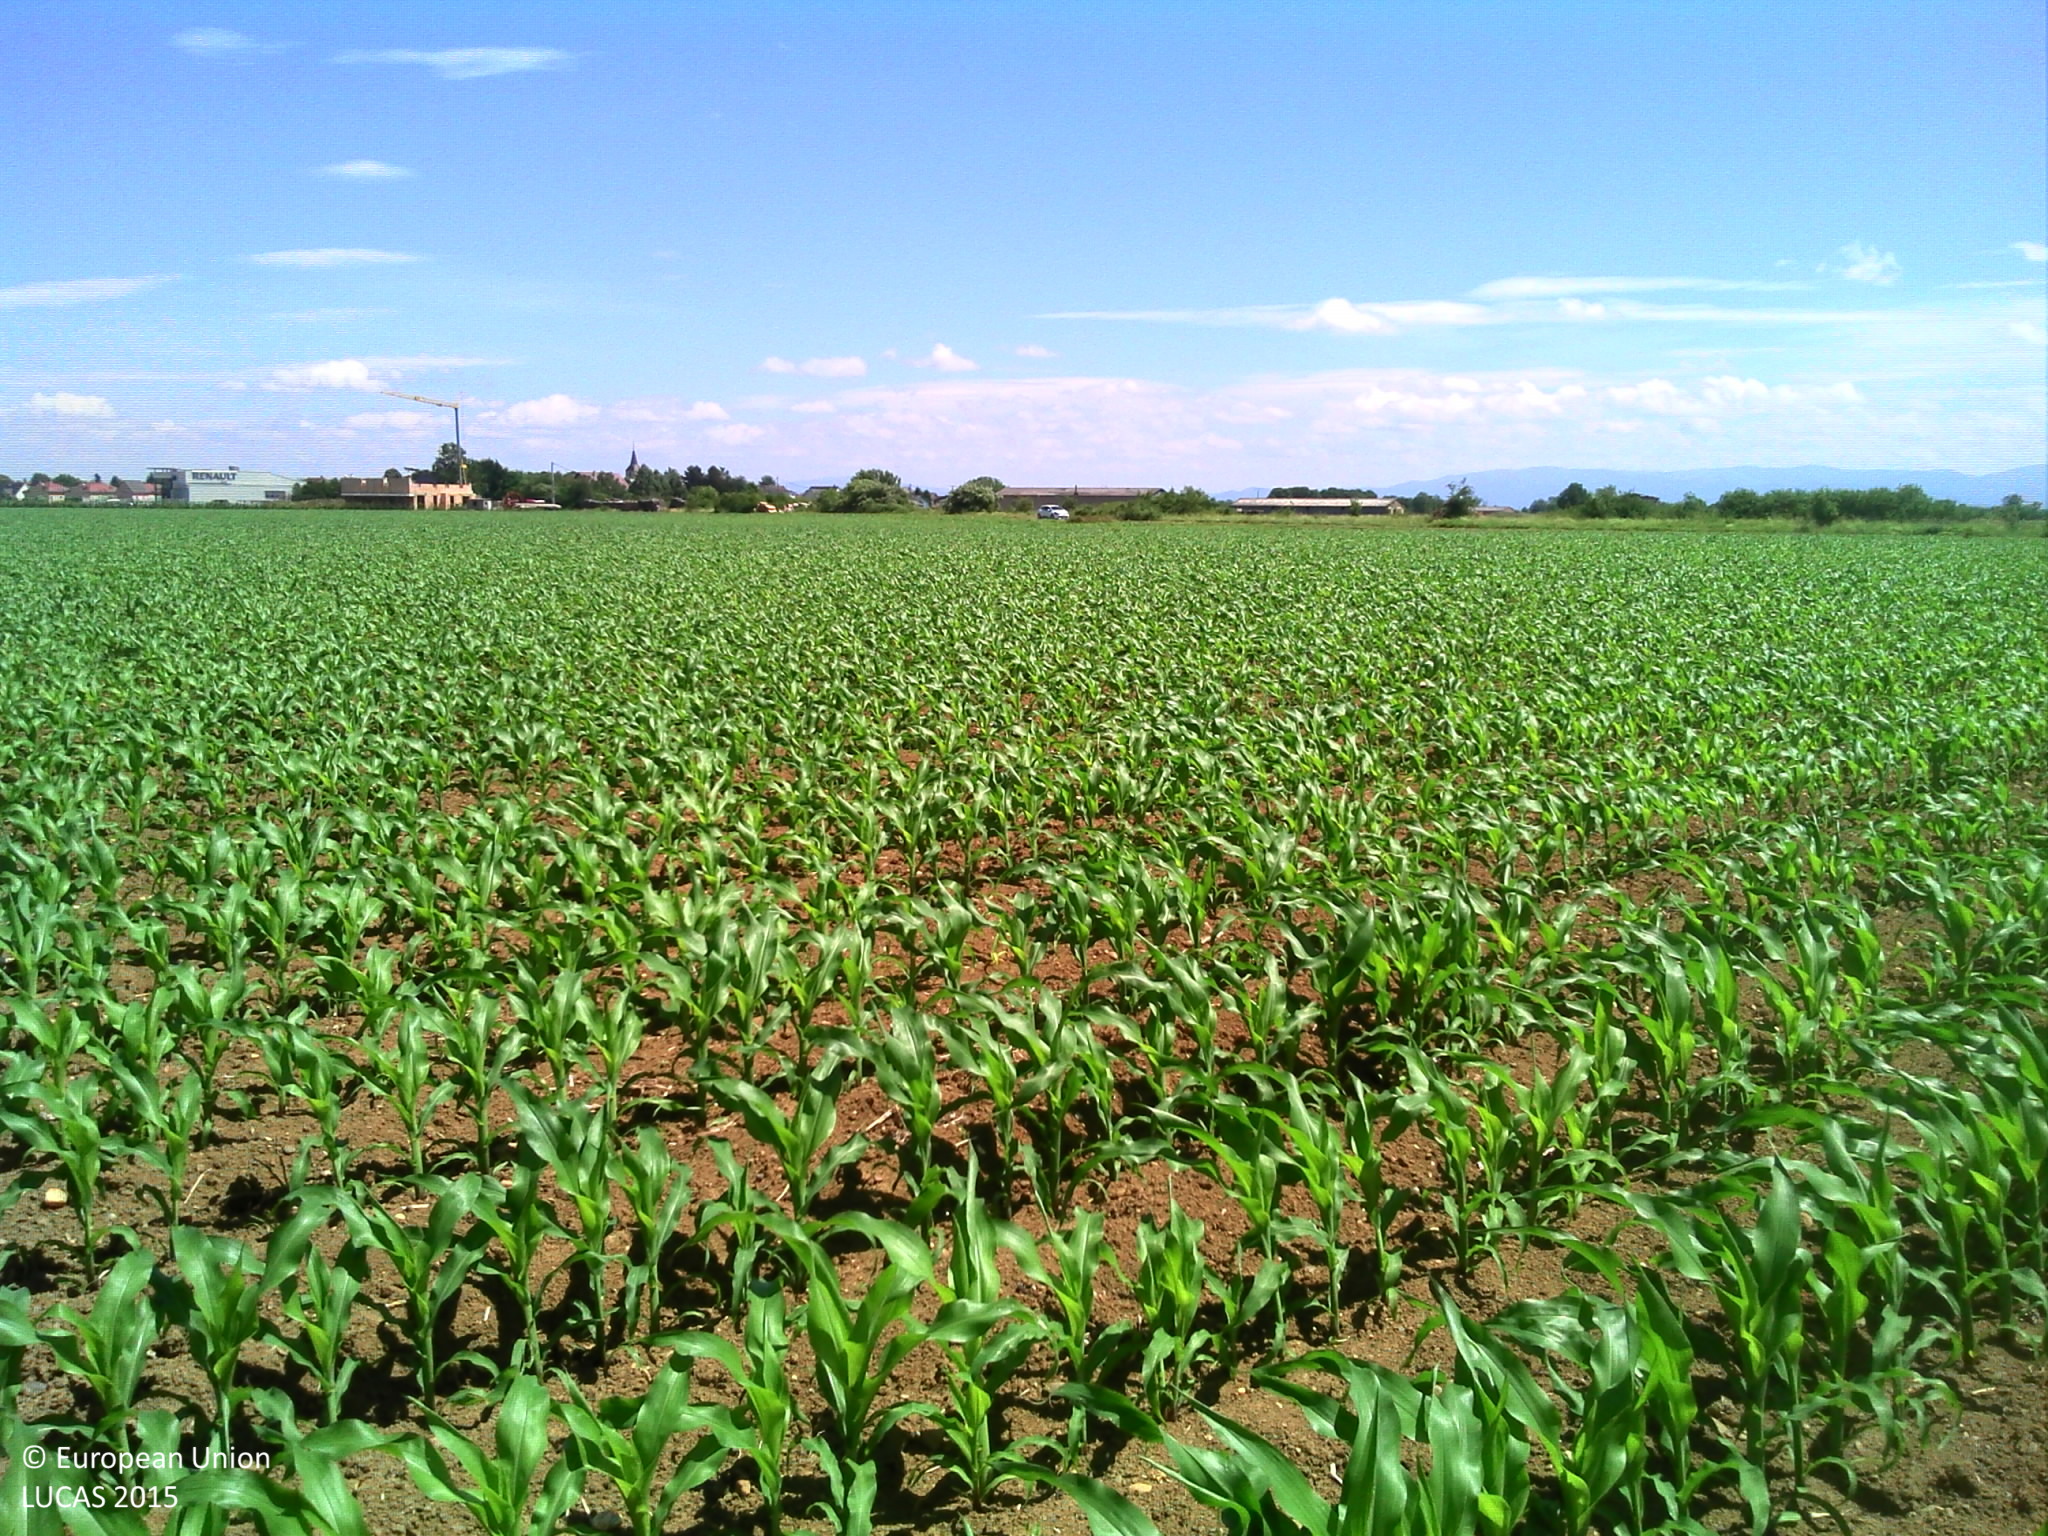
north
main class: Cropland
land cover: Maize
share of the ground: 25 - 50 %
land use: Agriculture (excluding fallow land and kitchen gardens)
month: June
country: FR
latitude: 47.9400
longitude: 7.3640
